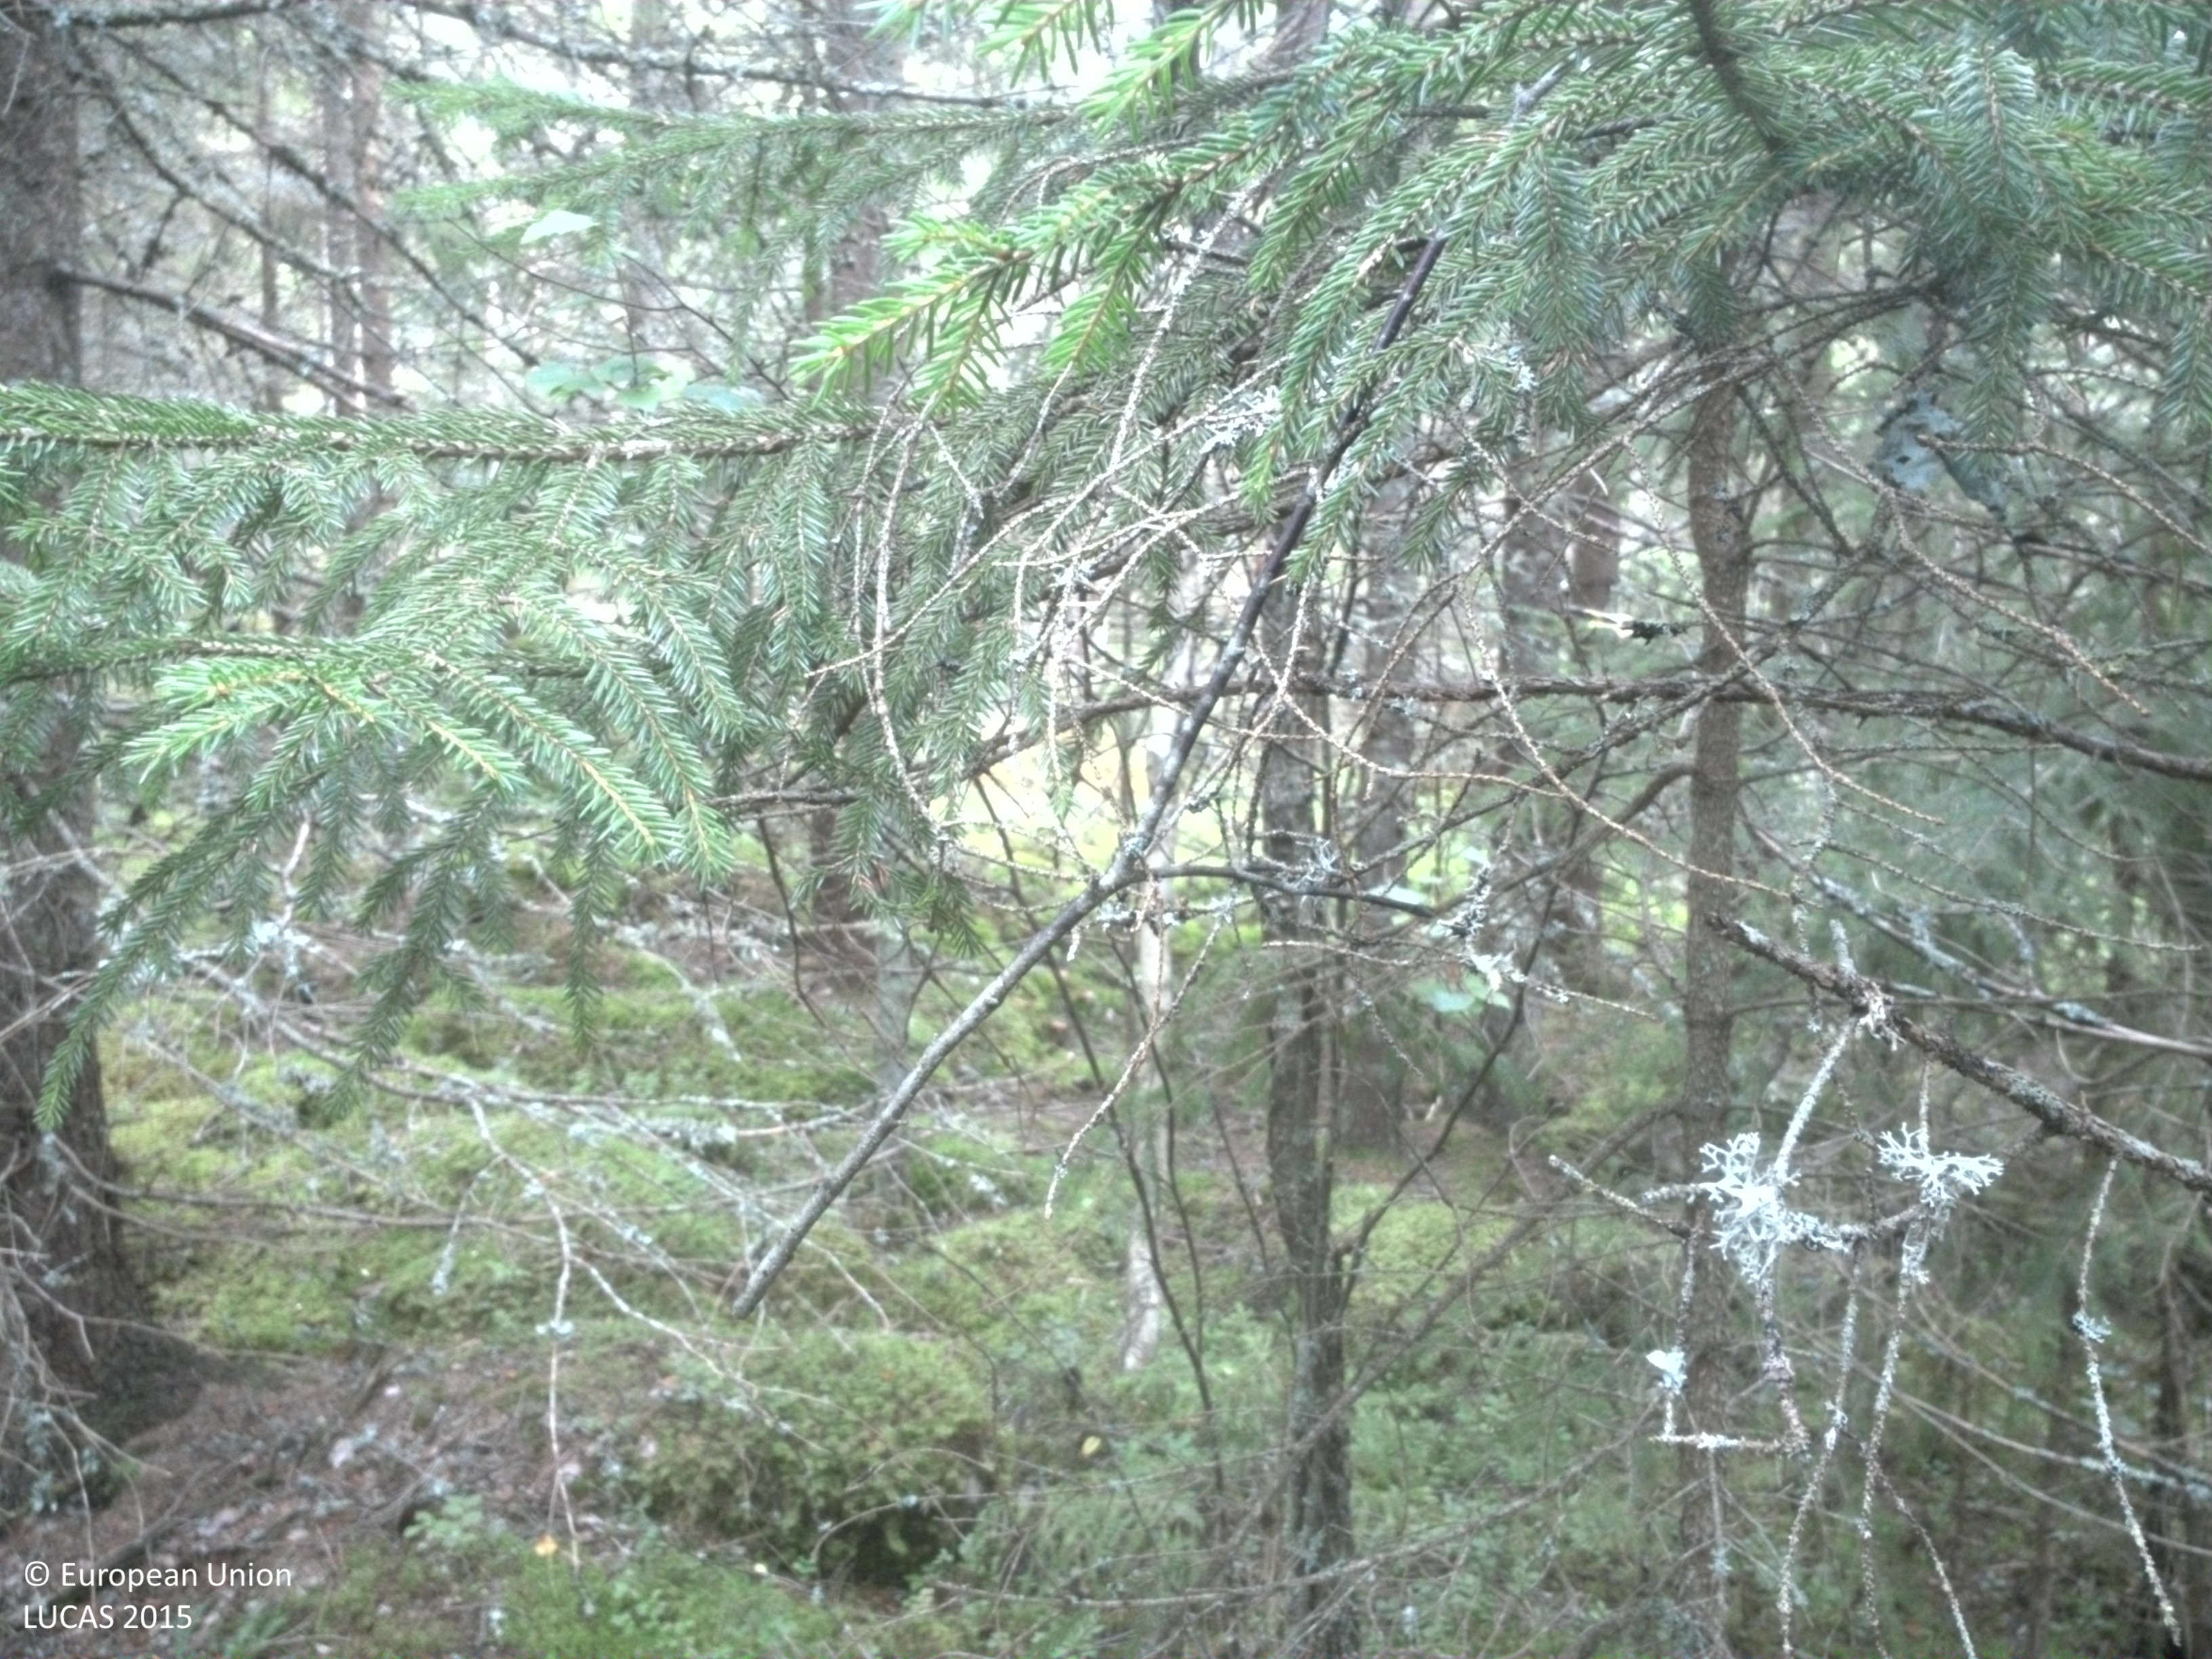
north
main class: Woodland
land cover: Spruce dominated coniferous woodland
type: boreal forest
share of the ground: > 75 %
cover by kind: coniferous forest trees 70 %, lichens and mosses 15 %, shrubs 10 %, broadleaved forest trees 5 %
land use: Forestry
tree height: > 5 m
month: August
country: SE
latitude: 59.7212
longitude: 15.7337
